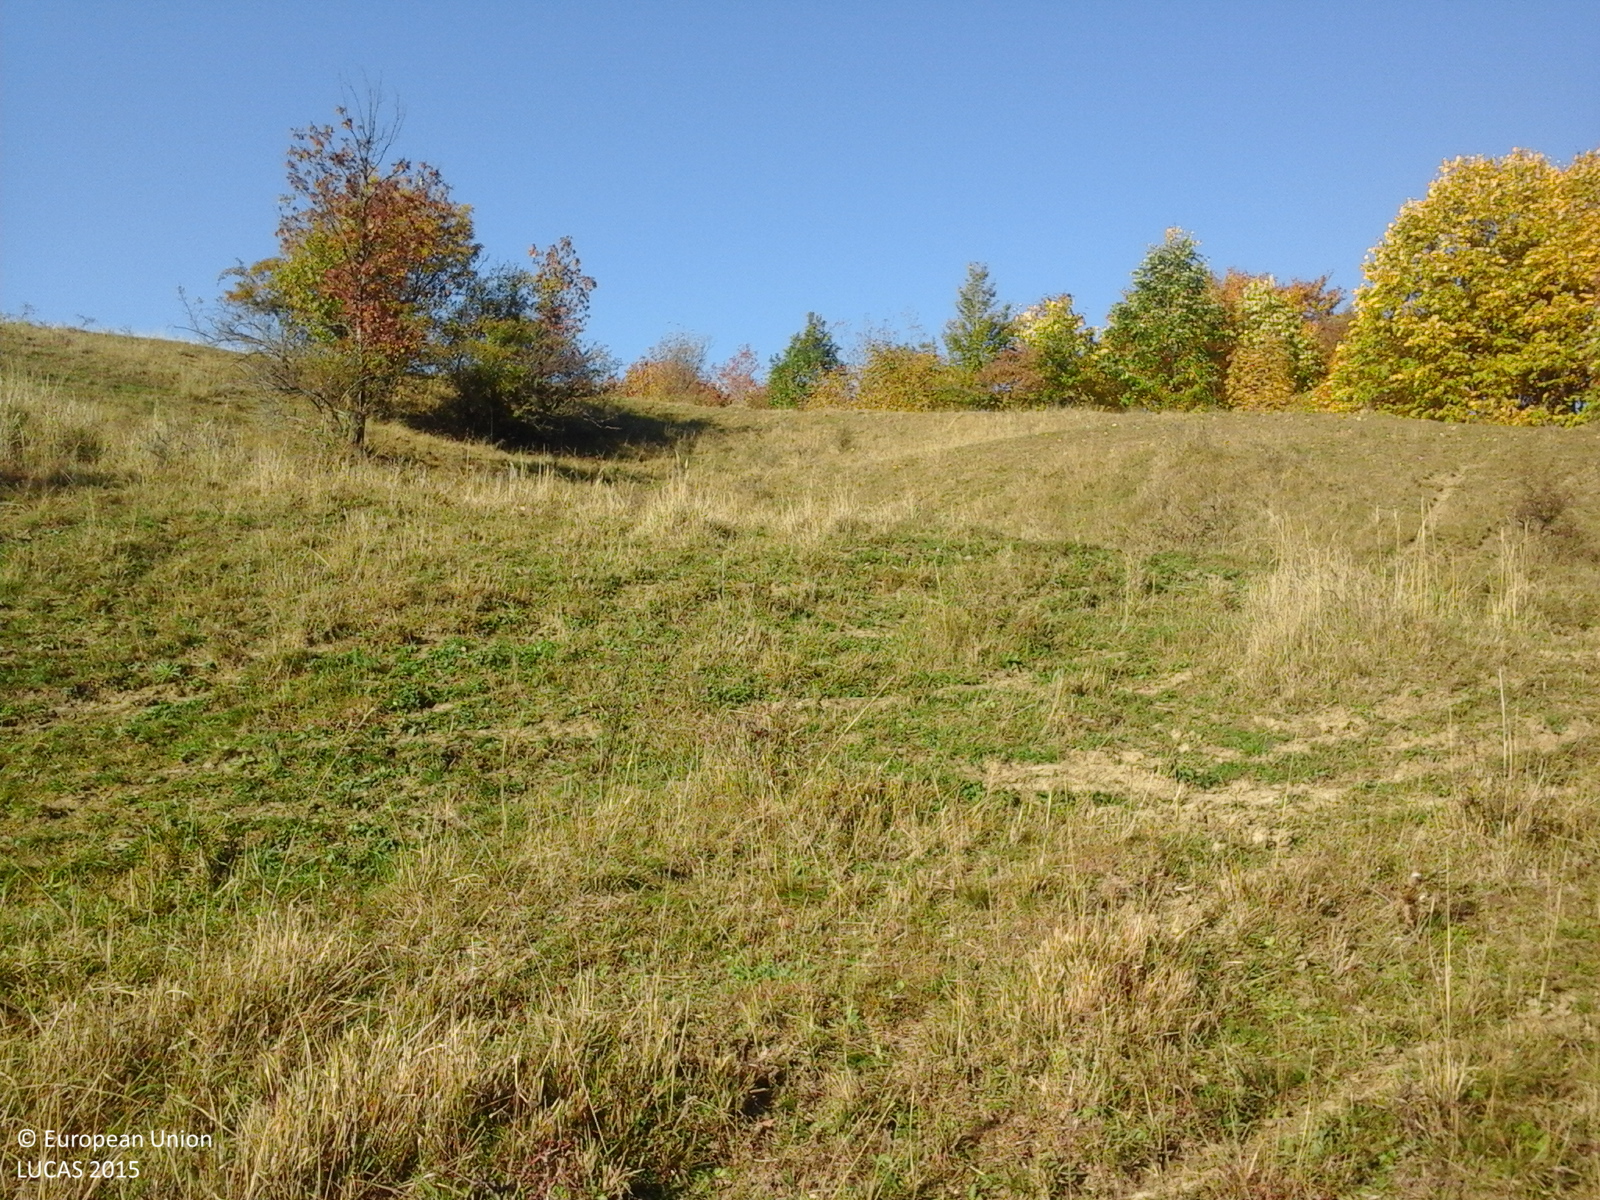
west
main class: Grassland
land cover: Grassland with sparse tree/shrub cover
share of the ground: > 75 %
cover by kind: herbaceous plants 85 %, shrubs 10 %, broadleaved forest trees 5 %
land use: Agriculture (excluding fallow land and kitchen gardens)
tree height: < 5 m
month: October
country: RO
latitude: 45.3618
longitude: 26.5561
